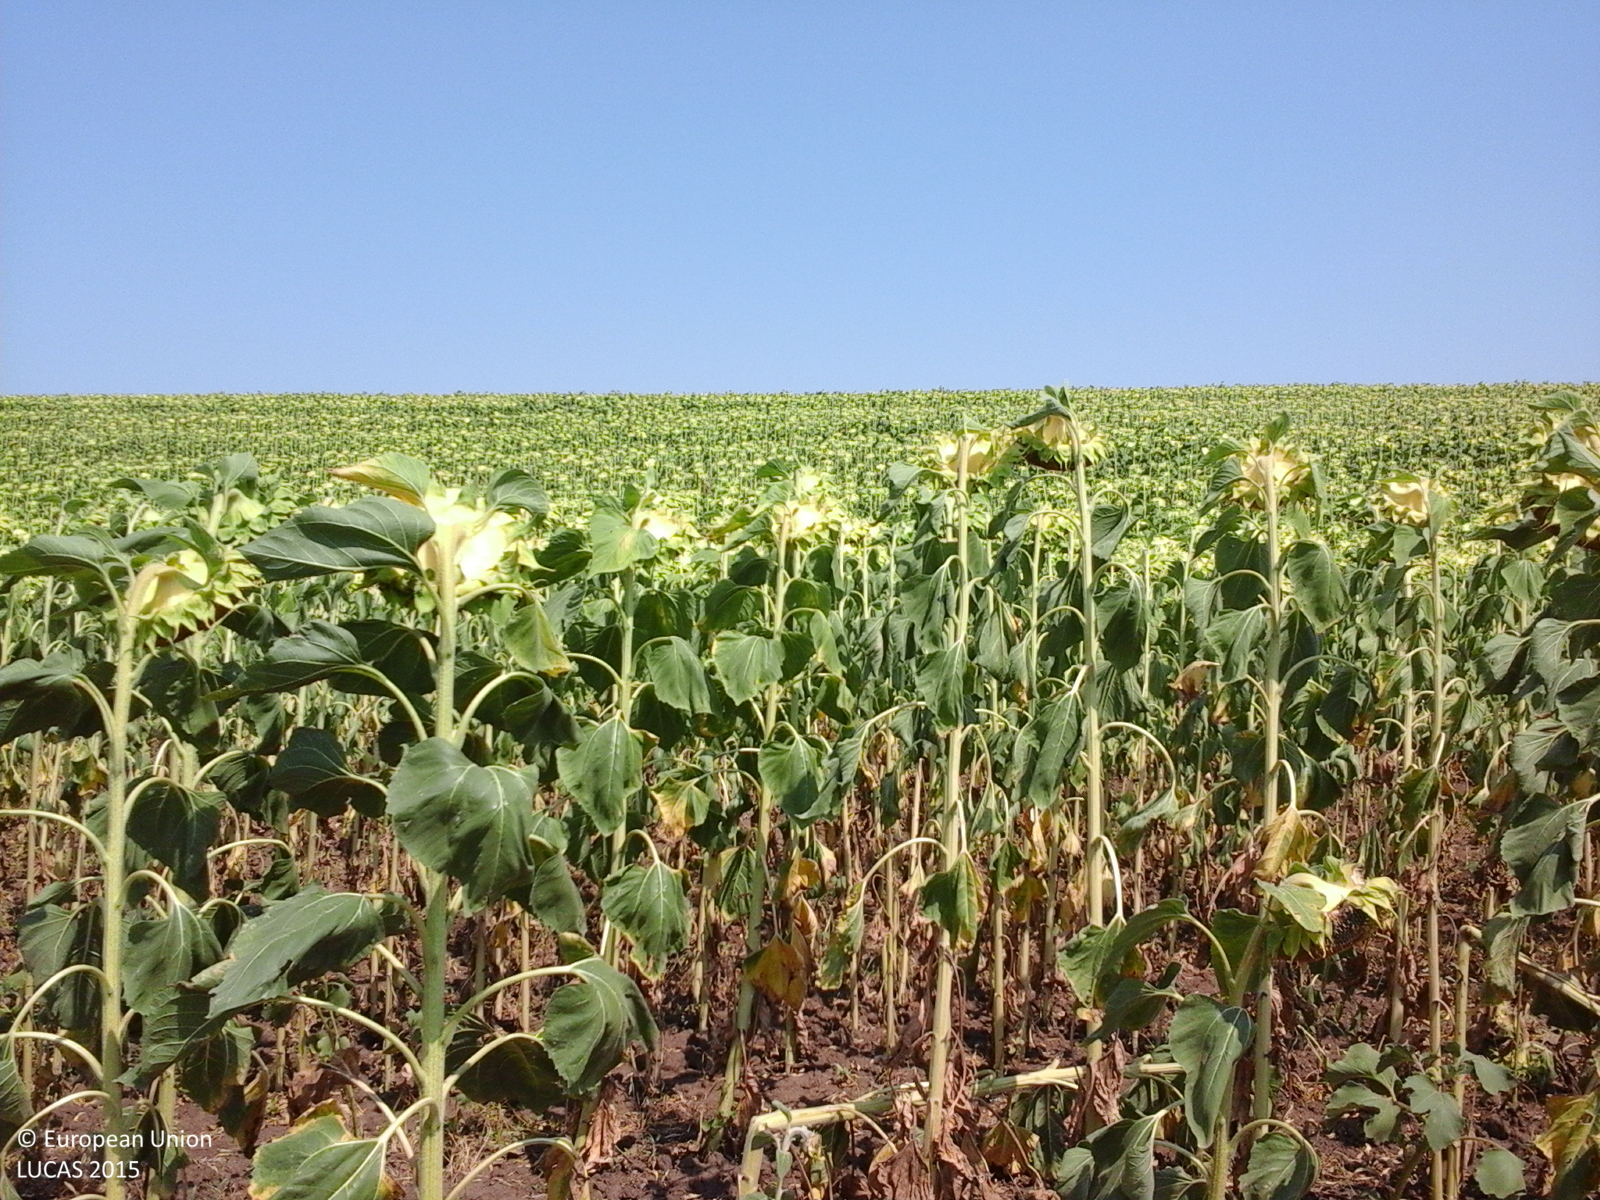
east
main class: Cropland
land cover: Sunflower
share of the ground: > 75 %
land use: Agriculture (excluding fallow land and kitchen gardens)
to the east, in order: Tracks; Sunflower
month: July
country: RO
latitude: 45.7001
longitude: 27.9574
